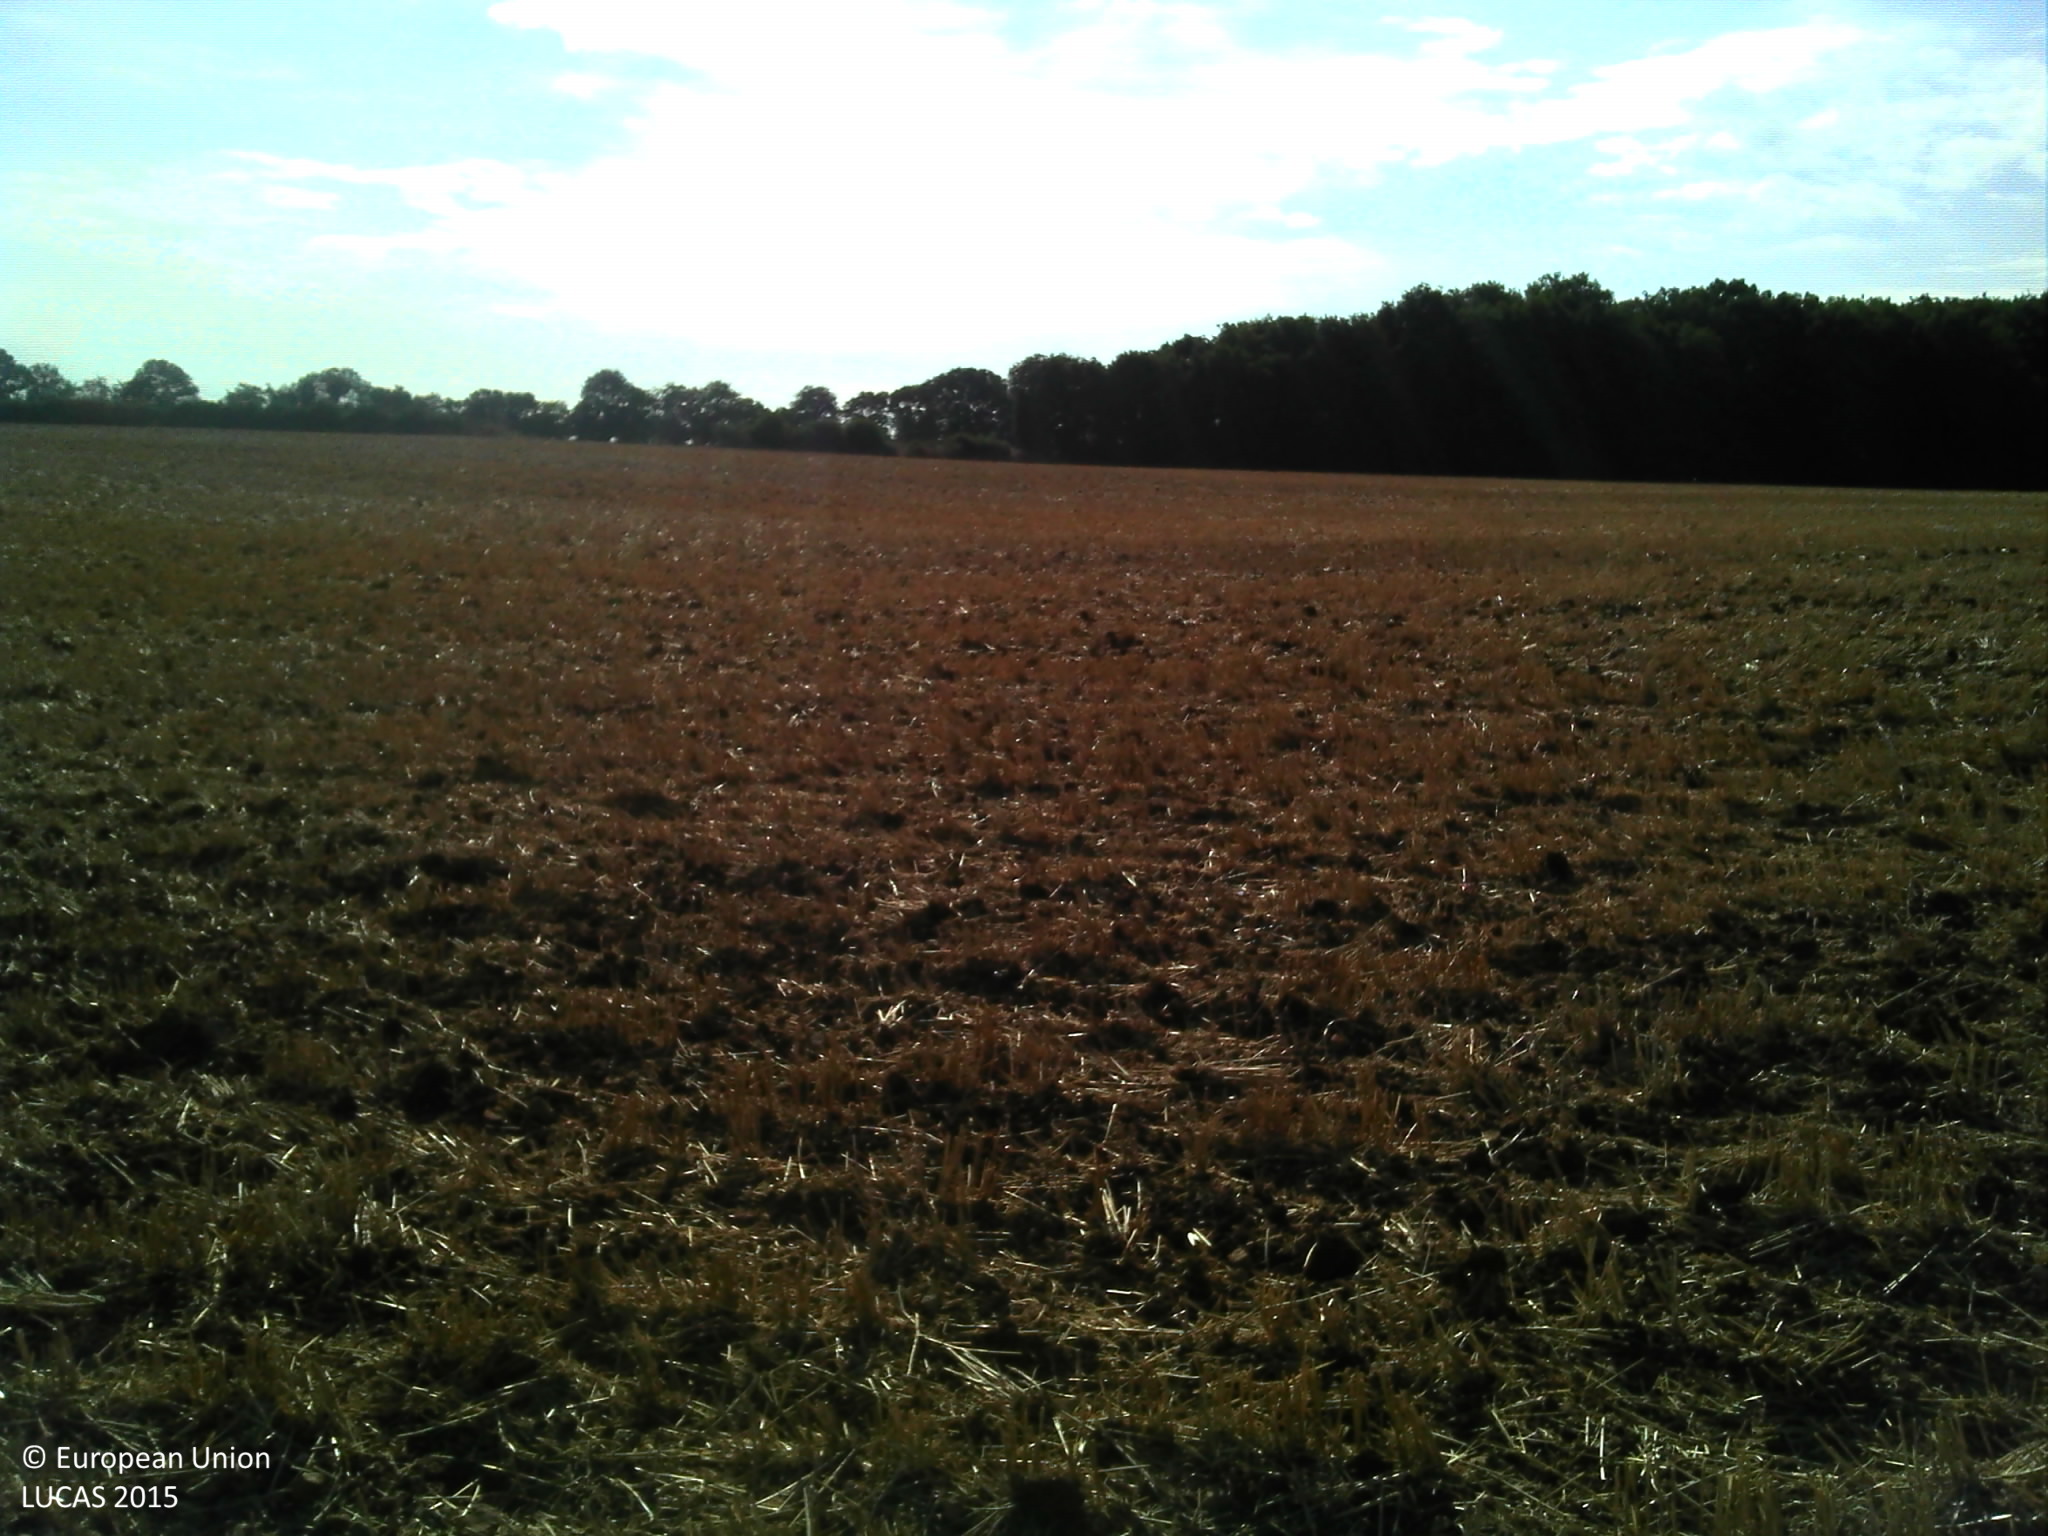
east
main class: Cropland
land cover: Common wheat
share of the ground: > 75 %
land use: Agriculture (excluding fallow land and kitchen gardens)
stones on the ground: 10 - 25 %
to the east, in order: Common wheat; Managed hedges; Common wheat
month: July
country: FR
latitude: 46.5908
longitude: 2.2013
